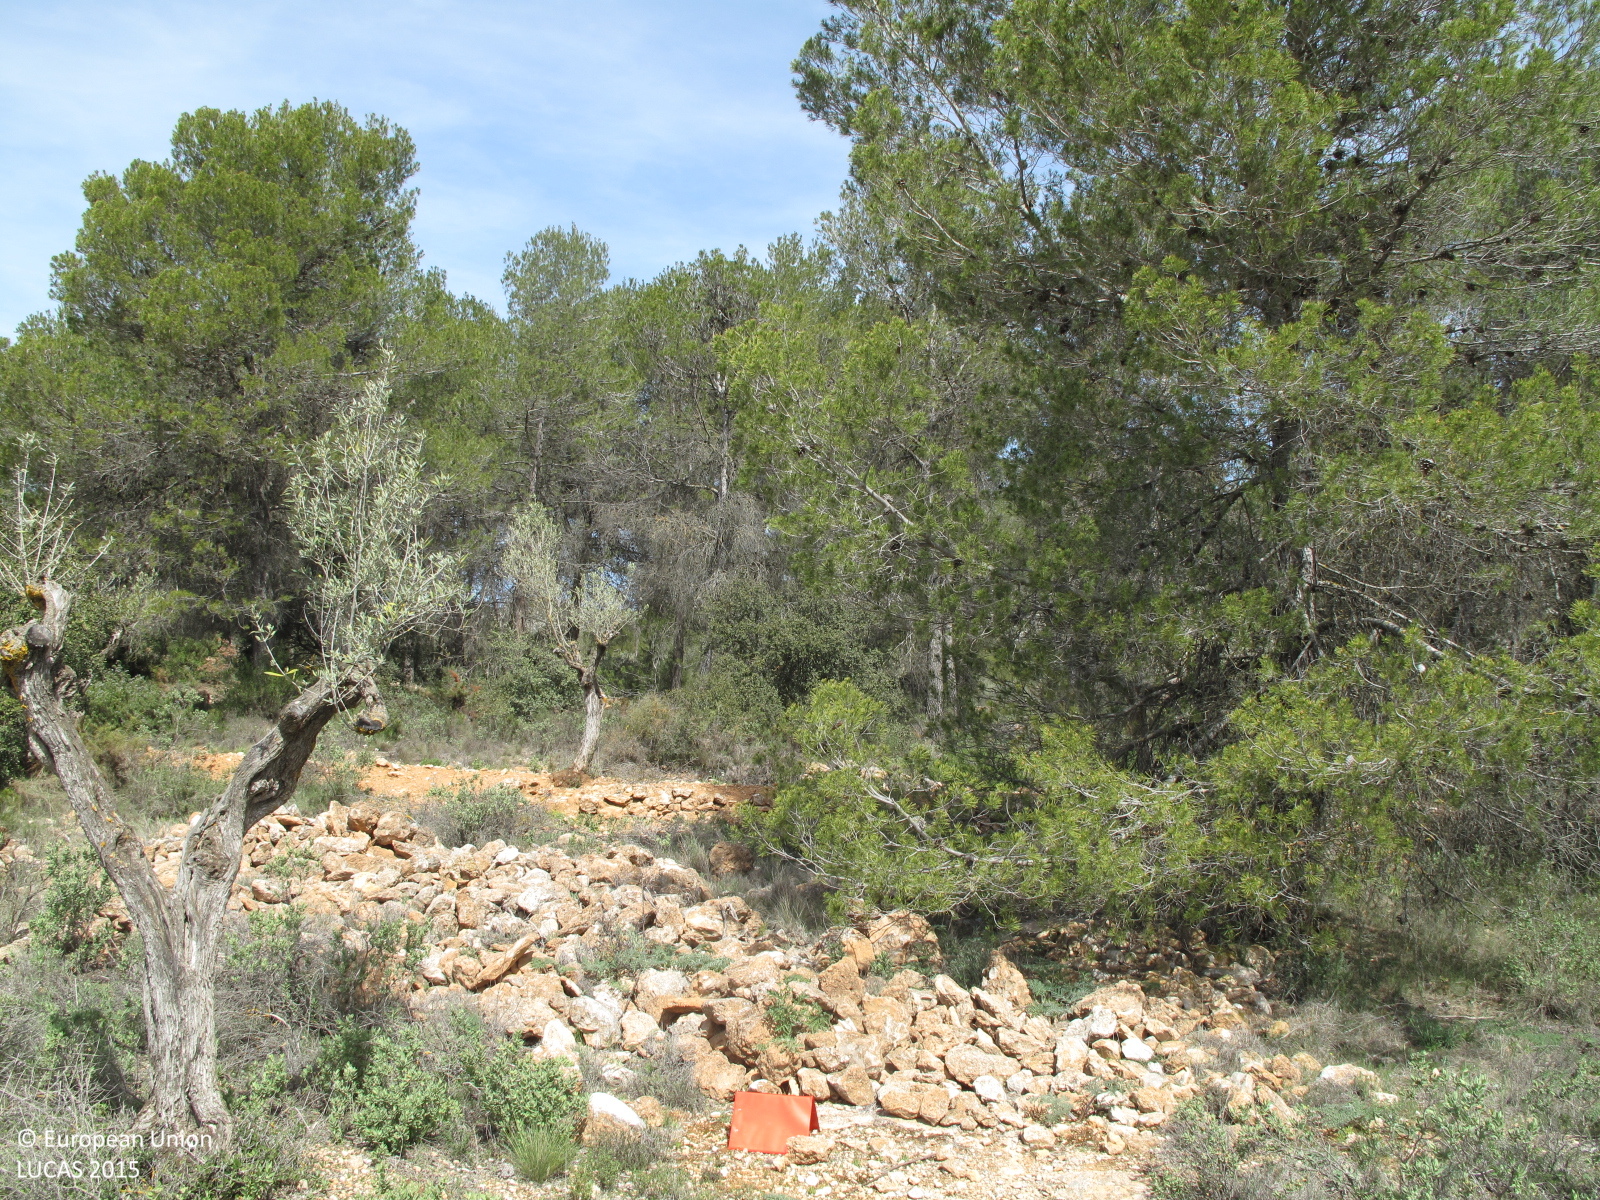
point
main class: Woodland
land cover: Pine dominated coniferous woodland
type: coniferous forest of the mediterranean region
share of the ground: 25 - 50 %
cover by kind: coniferous forest trees 40 %, shrubs 20 %, herbaceous plants 20 %, broadleaved forest trees 10 %, consolidated bare surface 10 %
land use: Semi-natural and natural areas not in use
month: March
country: ES
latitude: 38.7315
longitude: -0.7002
